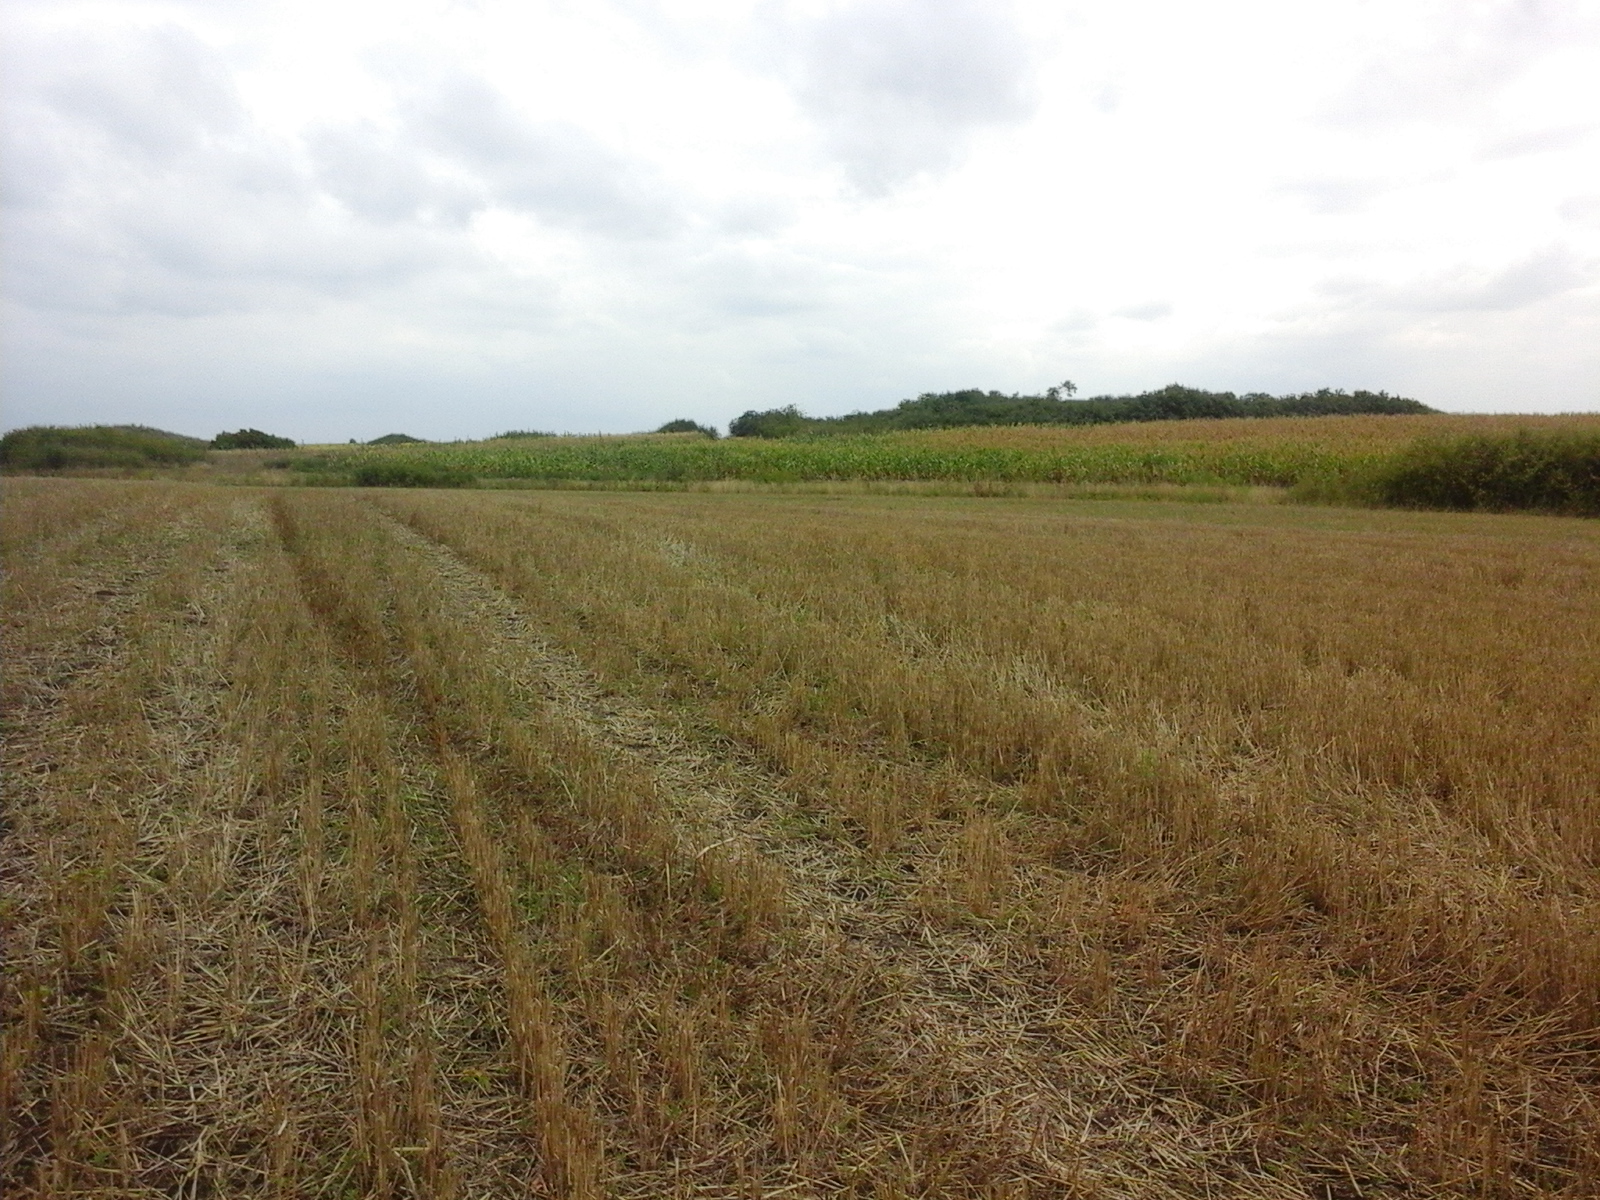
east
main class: Cropland
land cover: Common wheat
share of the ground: 50 - 75 %
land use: Agriculture (excluding fallow land and kitchen gardens)
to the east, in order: Common wheat; Grass margins; Ditches and canals; Grass margins; Tracks; Grass margins; Maize; Grass margins; Tracks; Grassland without tree/shrub cover; Abandoned hedges; Tracks; Grass margins; Other bare soil; Common wheat
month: August
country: RO
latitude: 45.5487
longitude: 21.3149
